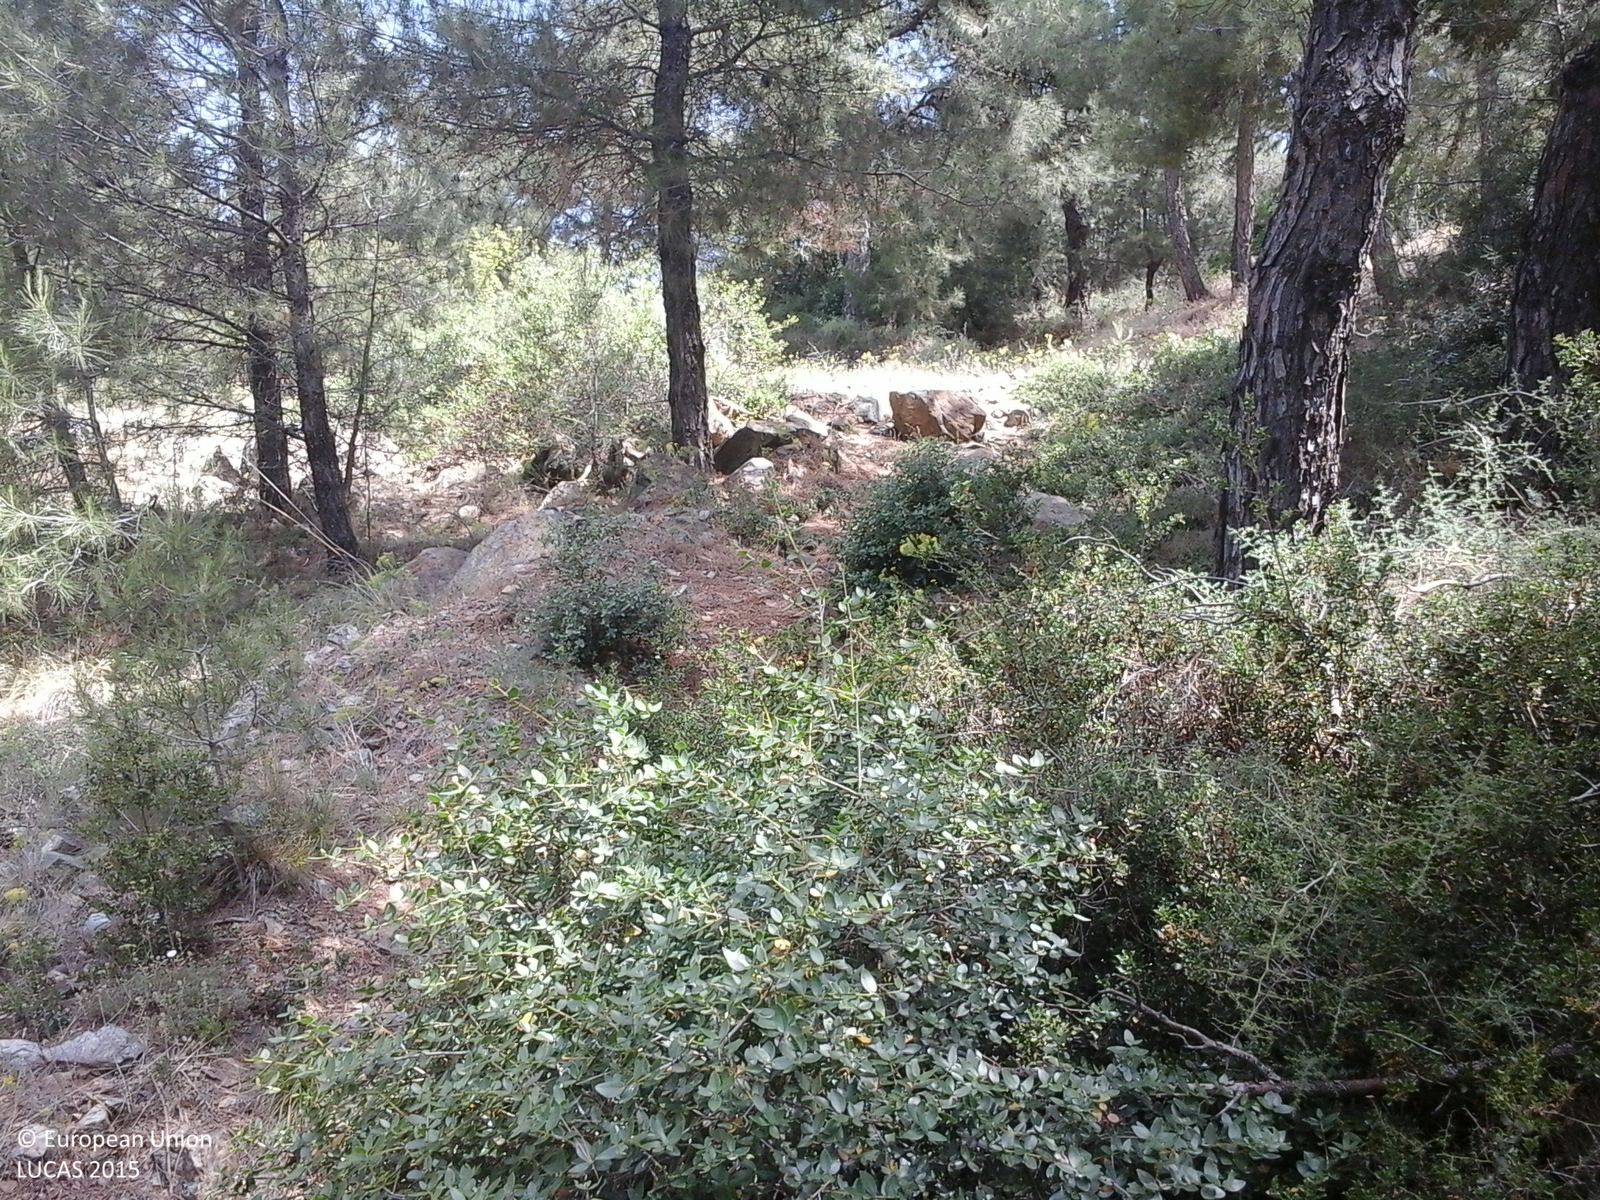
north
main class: Woodland
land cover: Pine dominated coniferous woodland
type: coniferous forest of the mediterranean region
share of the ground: > 75 %
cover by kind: coniferous forest trees 75 %, herbaceous plants 10 %, consolidated bare surface 10 %, shrubs 5 %
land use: Amenities, museums, leisure
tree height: > 5 m
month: June
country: GR
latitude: 40.6451
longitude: 22.9800
